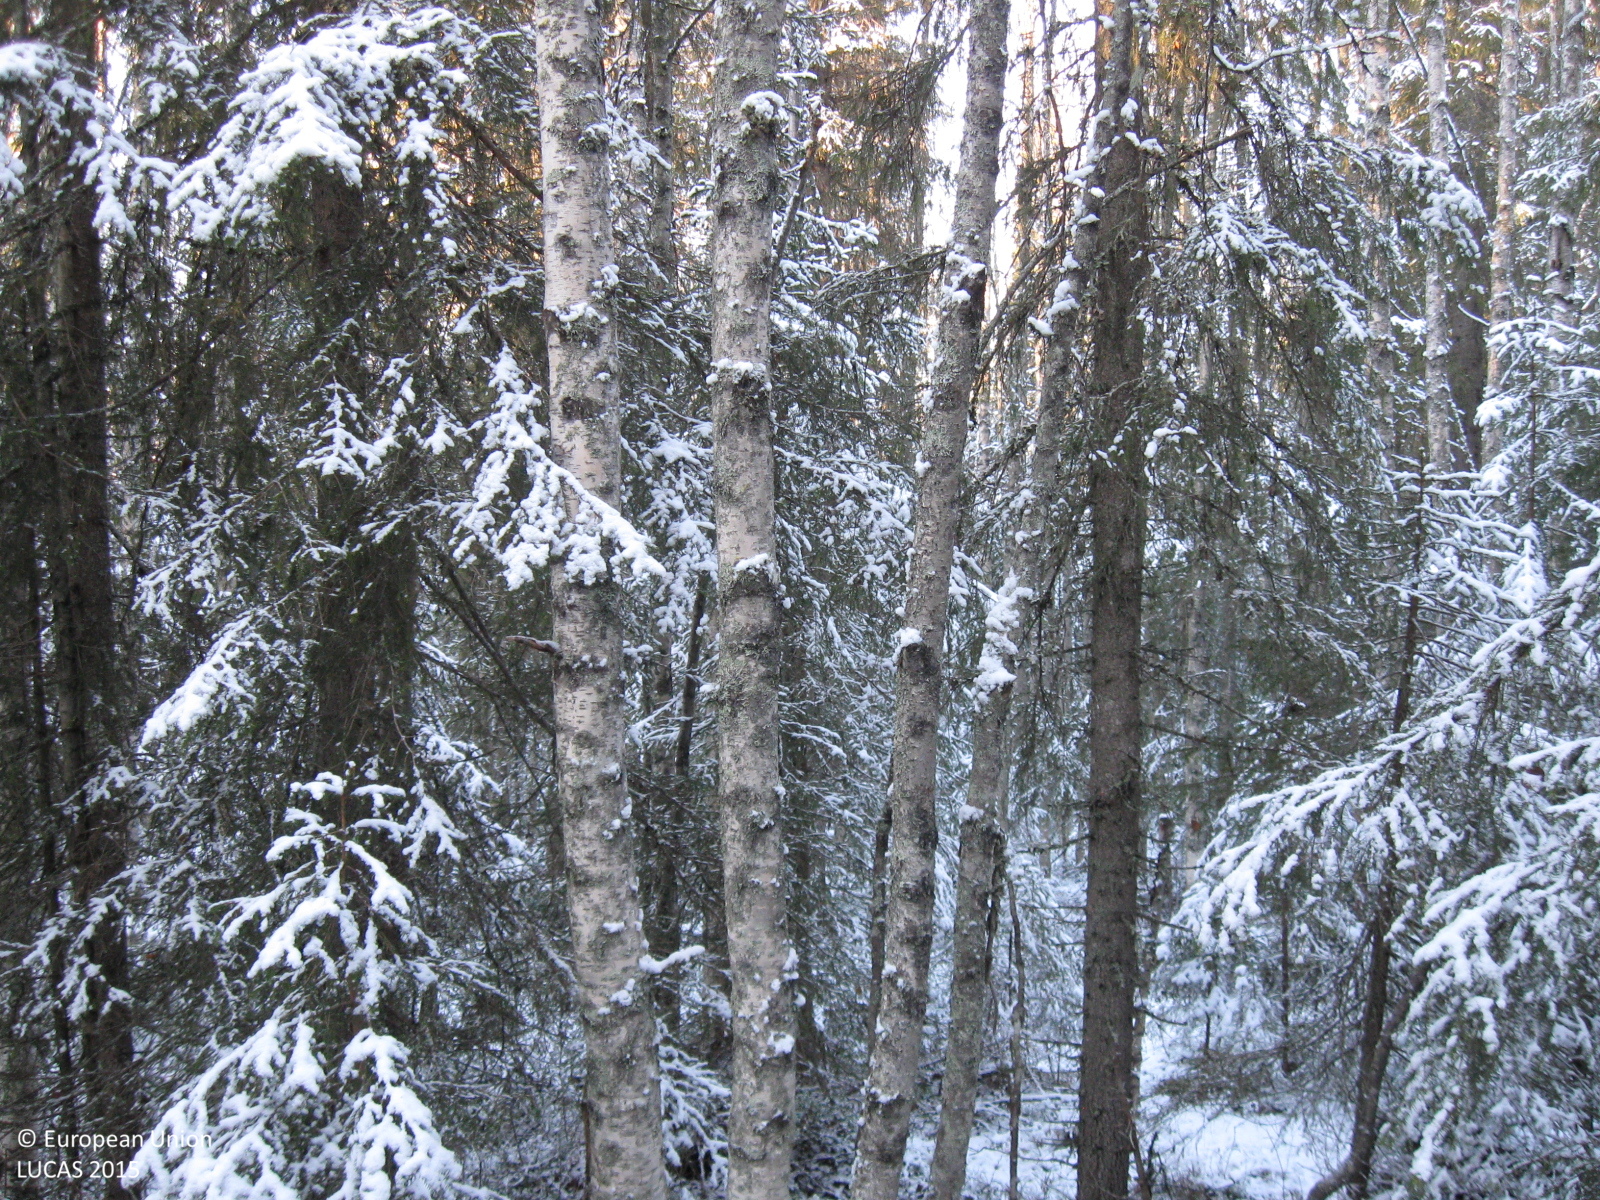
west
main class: Woodland
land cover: Spruce dominated mixed woodland
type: boreal forest
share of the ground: > 75 %
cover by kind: coniferous forest trees 55 %, broadleaved forest trees 30 %, shrubs 5 %, herbaceous plants 5 %, lichens and mosses 5 %
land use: Forestry
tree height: > 5 m
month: October
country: SE
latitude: 66.3578
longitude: 21.5176
